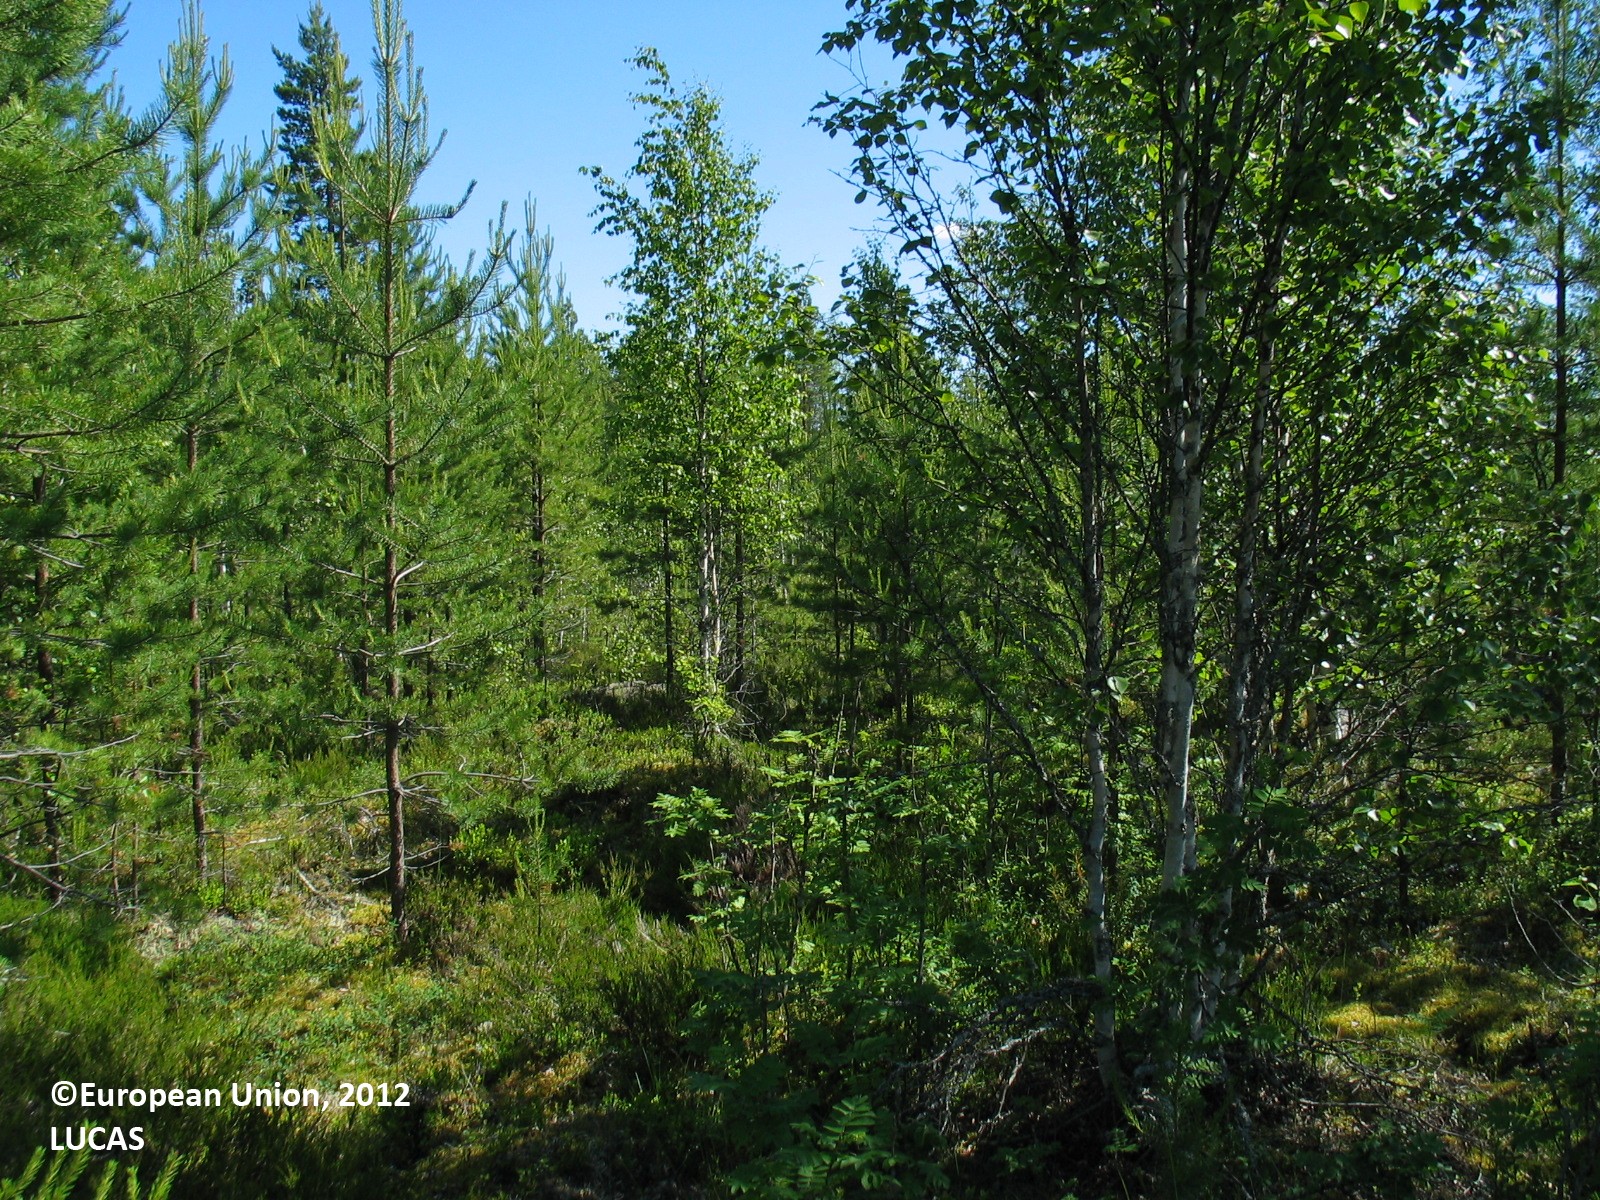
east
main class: Woodland
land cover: Other mixed woodland
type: boreal forest
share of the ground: 25 - 50 %
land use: Forestry
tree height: > 5 m
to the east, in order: Other mixed woodland; Ditches and canals; Pine dominated coniferous woodland; Ditches and canals; Other mixed woodland; Ditches and canals; Pine dominated coniferous woodland
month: July
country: FI
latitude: 64.4813
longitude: 26.4019
